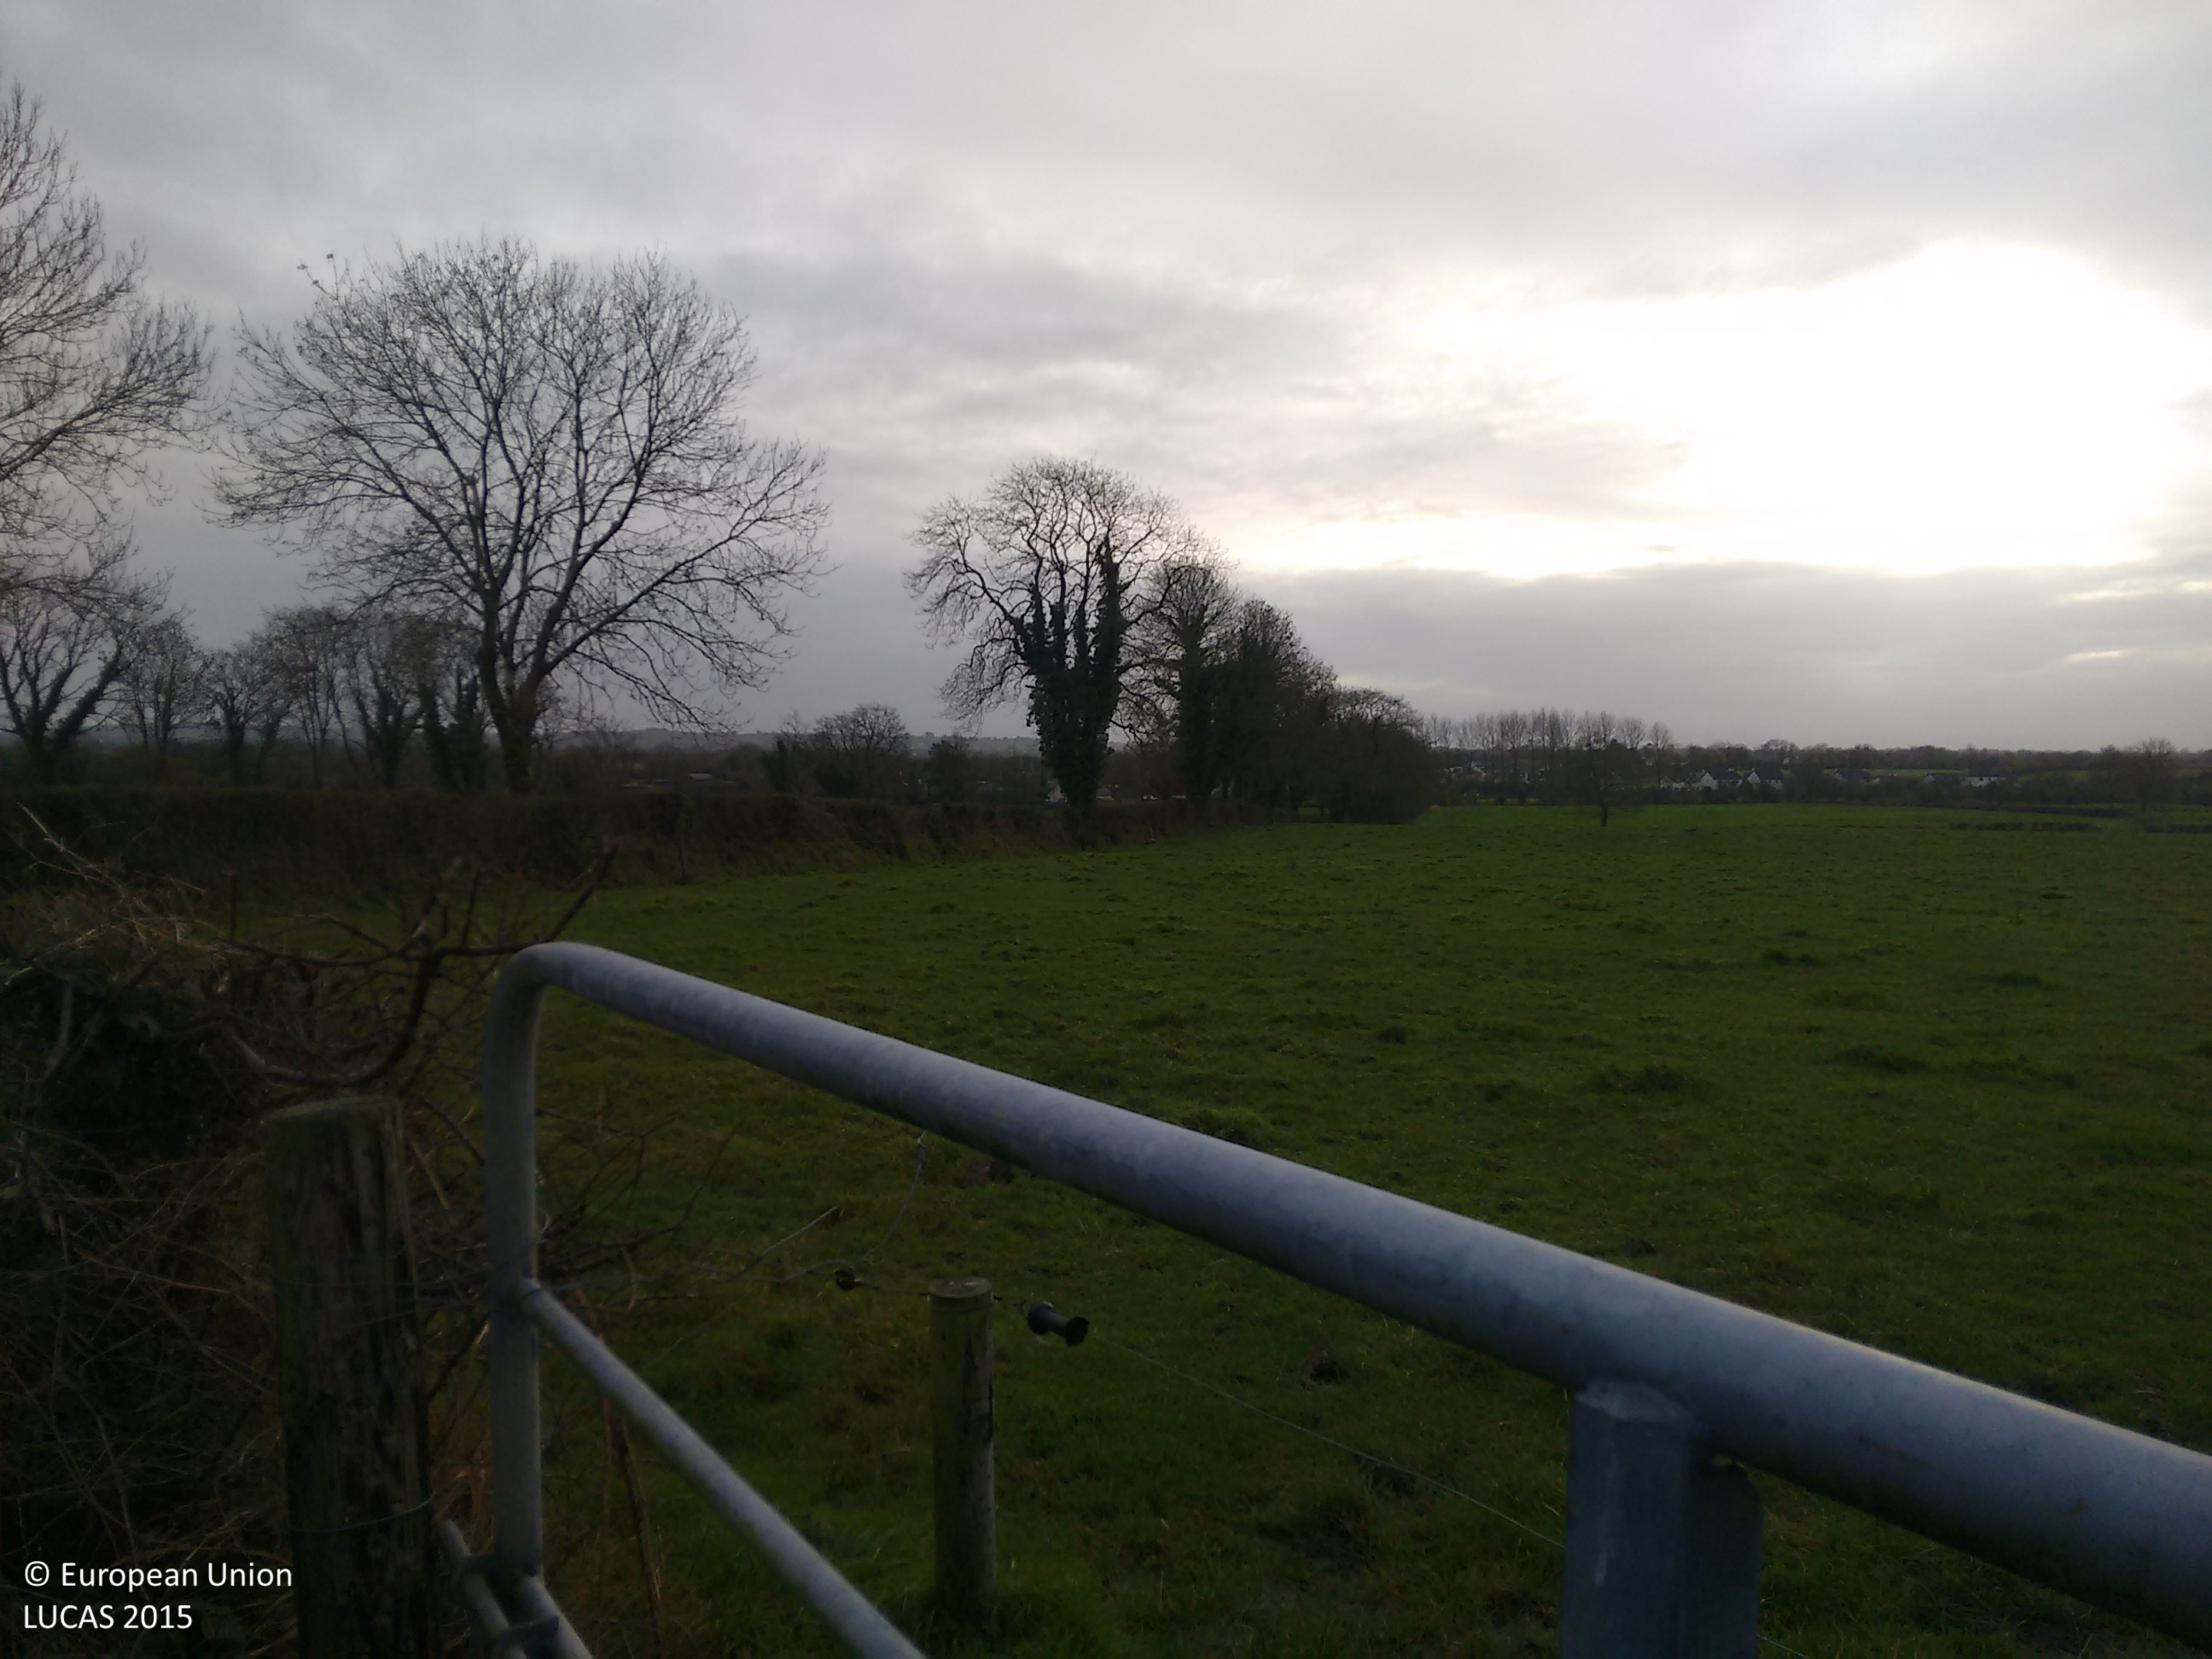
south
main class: Grassland
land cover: Grassland without tree/shrub cover
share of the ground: > 75 %
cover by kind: herbaceous plants 100 %
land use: Agriculture (excluding fallow land and kitchen gardens)
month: November
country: IE
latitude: 53.7671
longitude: -7.7806
